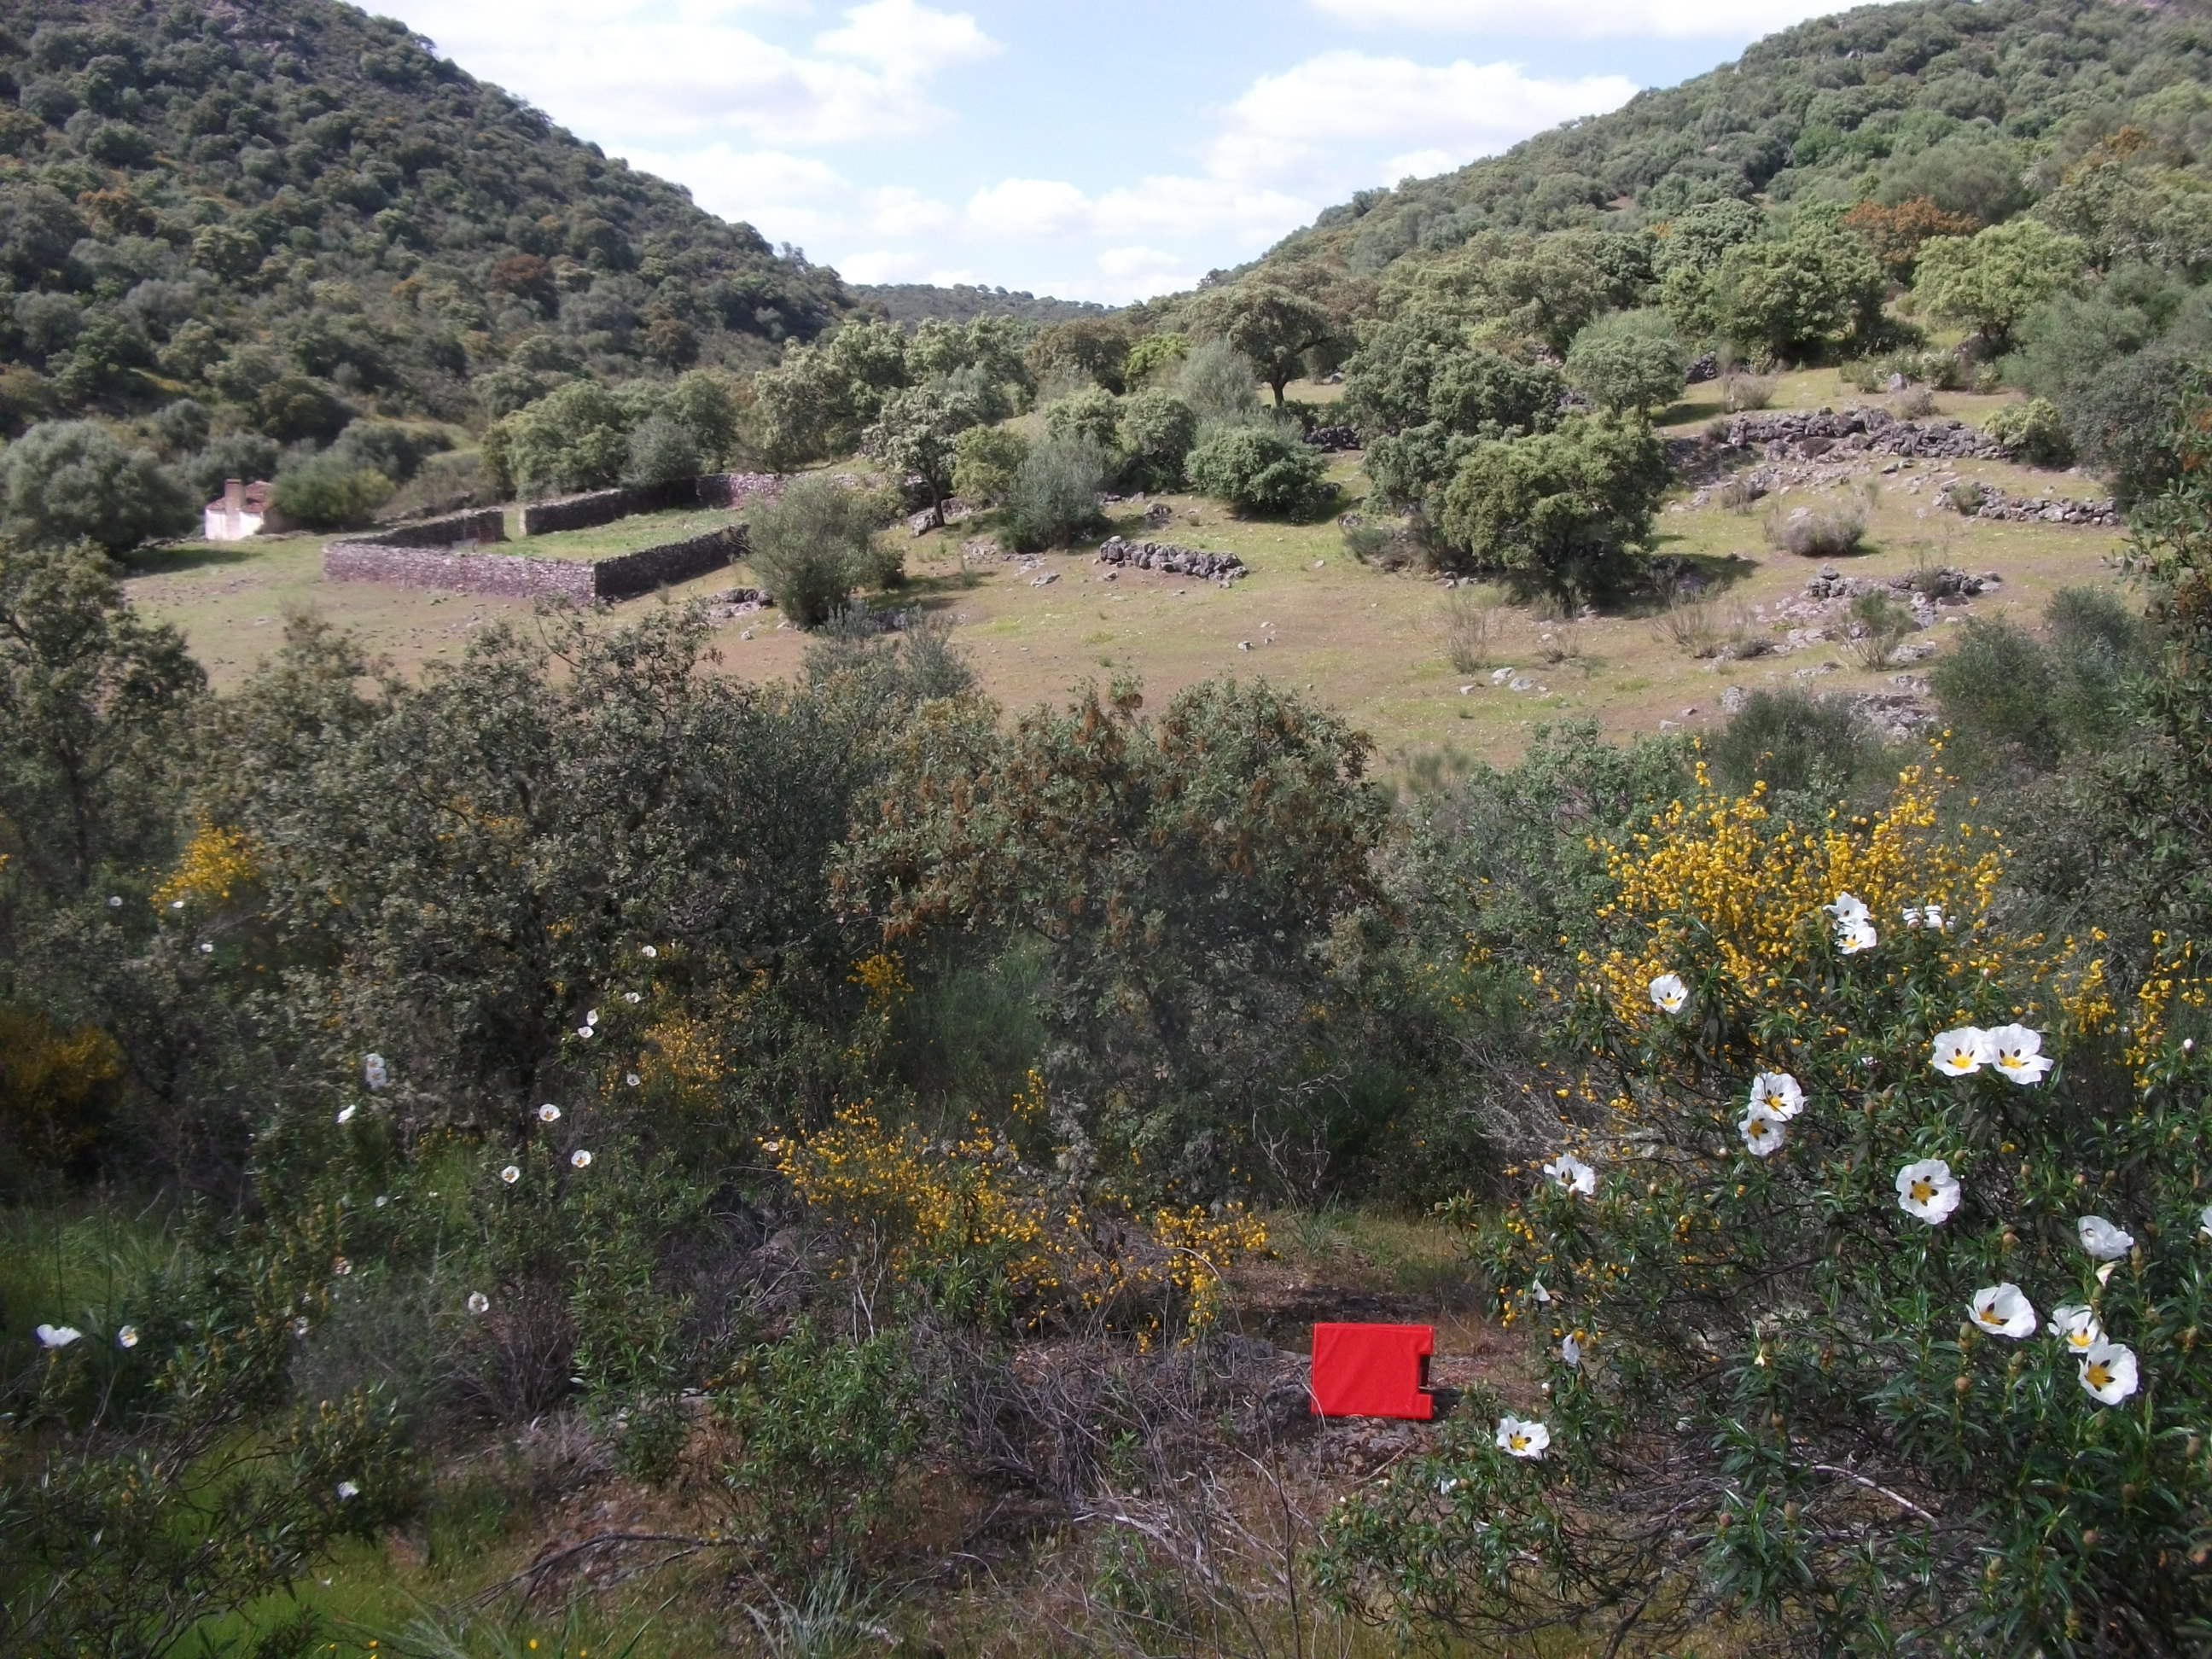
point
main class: Woodland
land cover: Broadleaved woodland
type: broadleaved evergreen forest
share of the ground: 25 - 50 %
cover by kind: shrubs 60 %, broadleaved forest trees 35 %, herbaceous plants 5 %
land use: Semi-natural and natural areas not in use
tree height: > 5 m
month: April
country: ES
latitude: 38.0738
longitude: -6.7738
